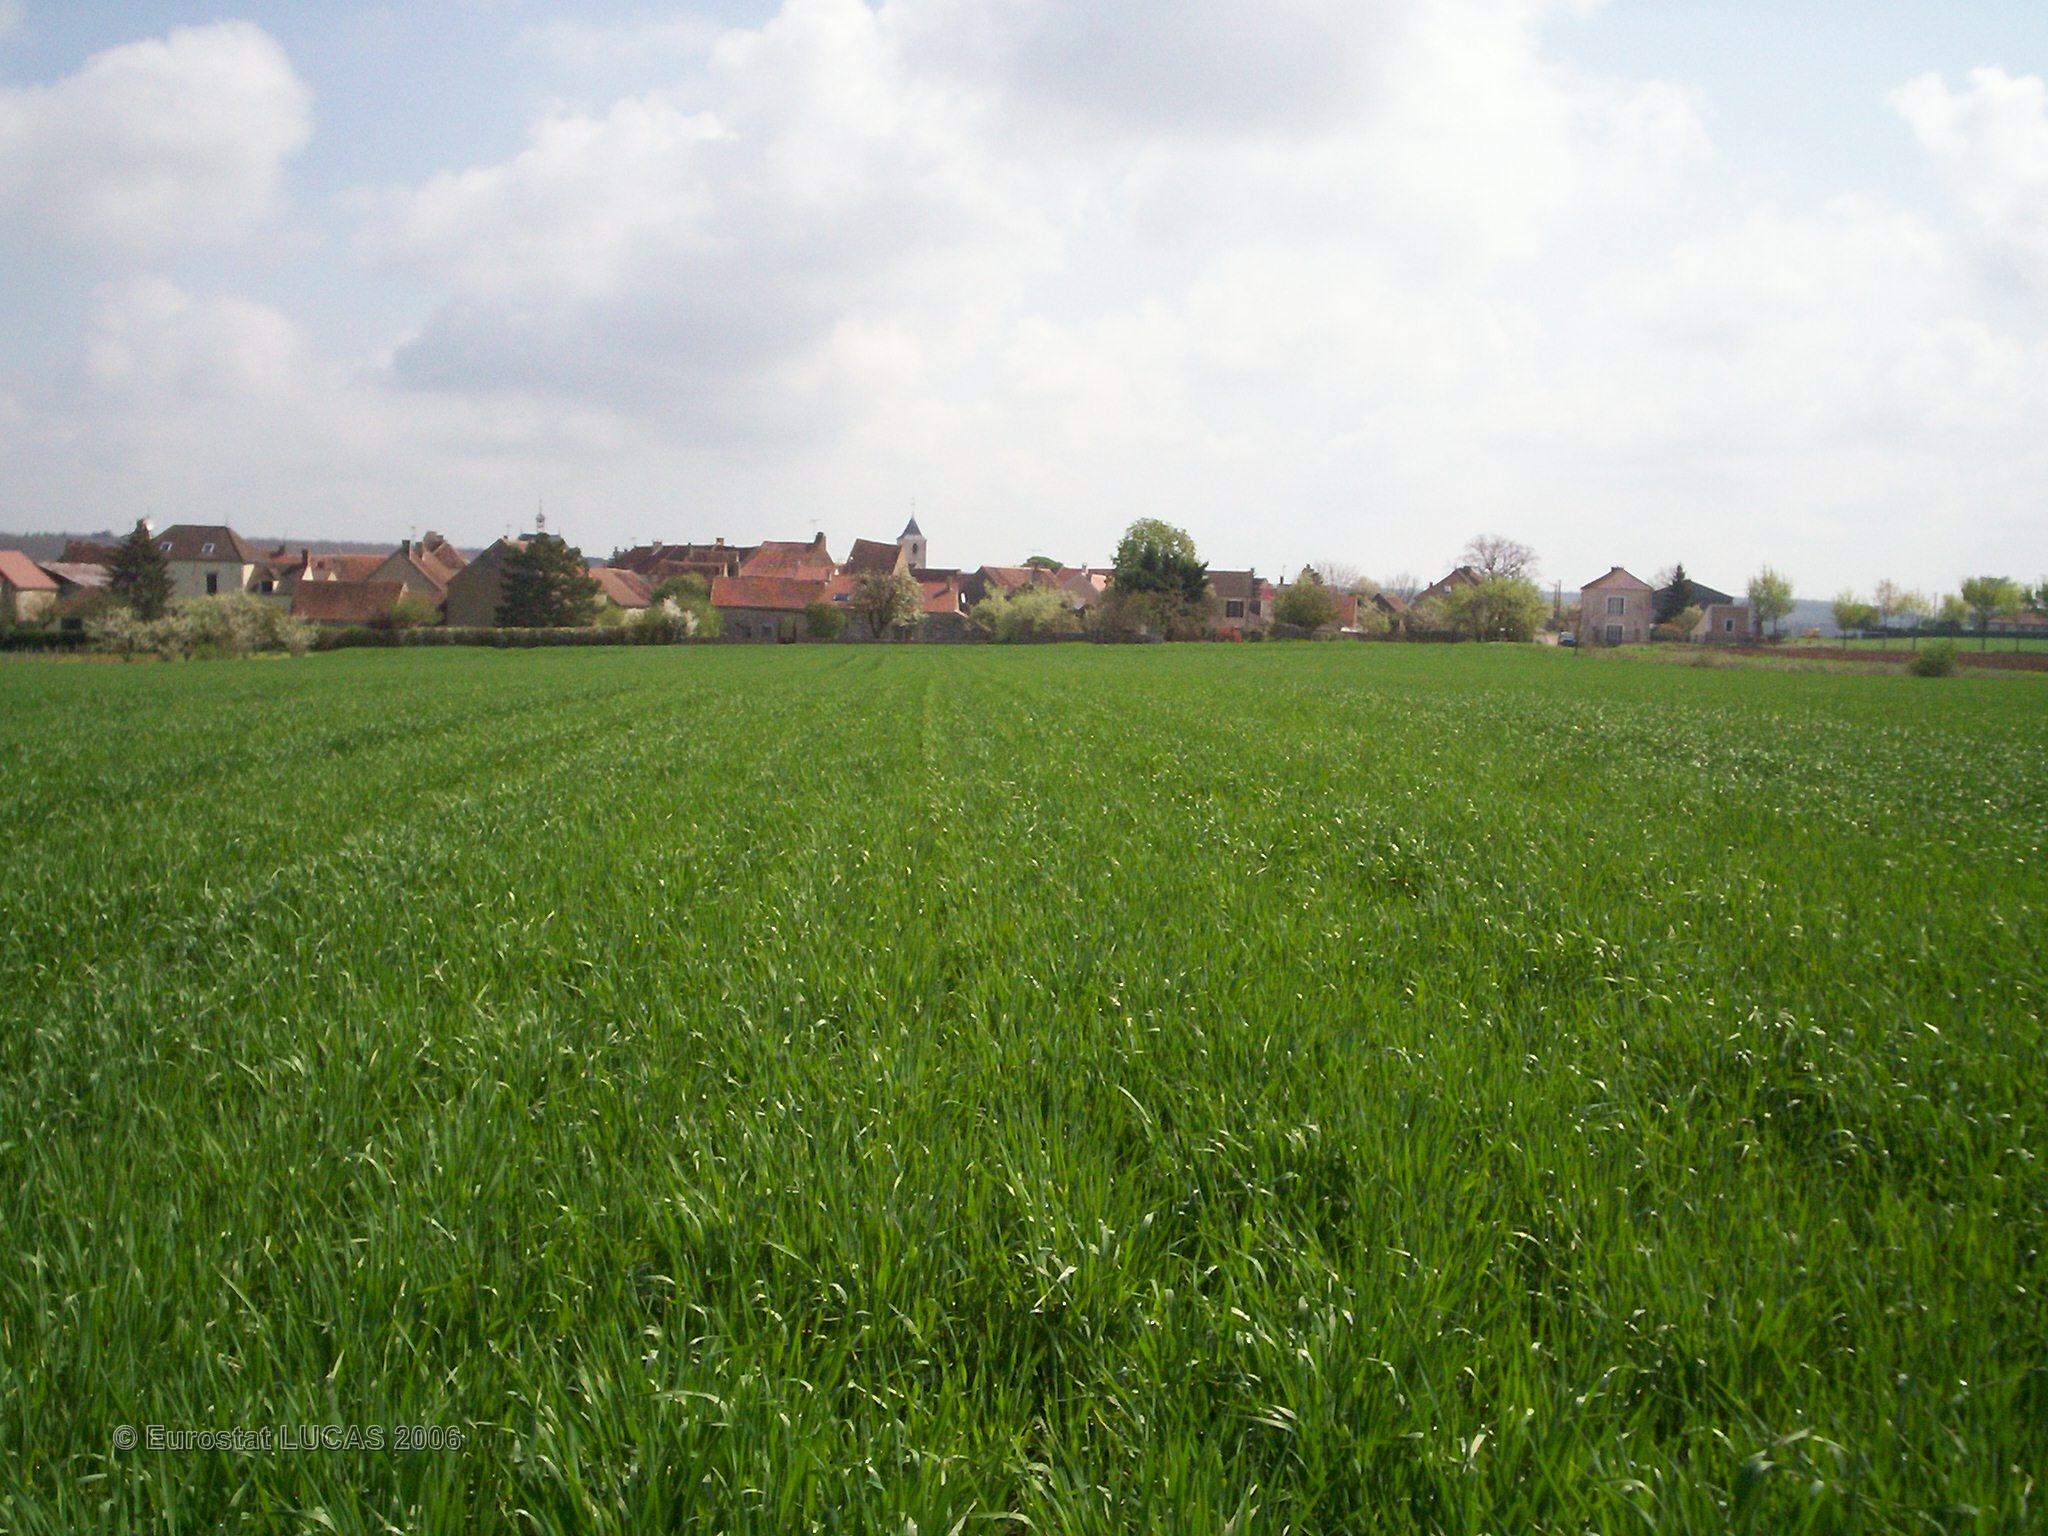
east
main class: Cropland
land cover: Barley
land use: Agriculture (excluding fallow land and kitchen gardens)
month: April
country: FR
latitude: 47.7270
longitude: 3.8505
